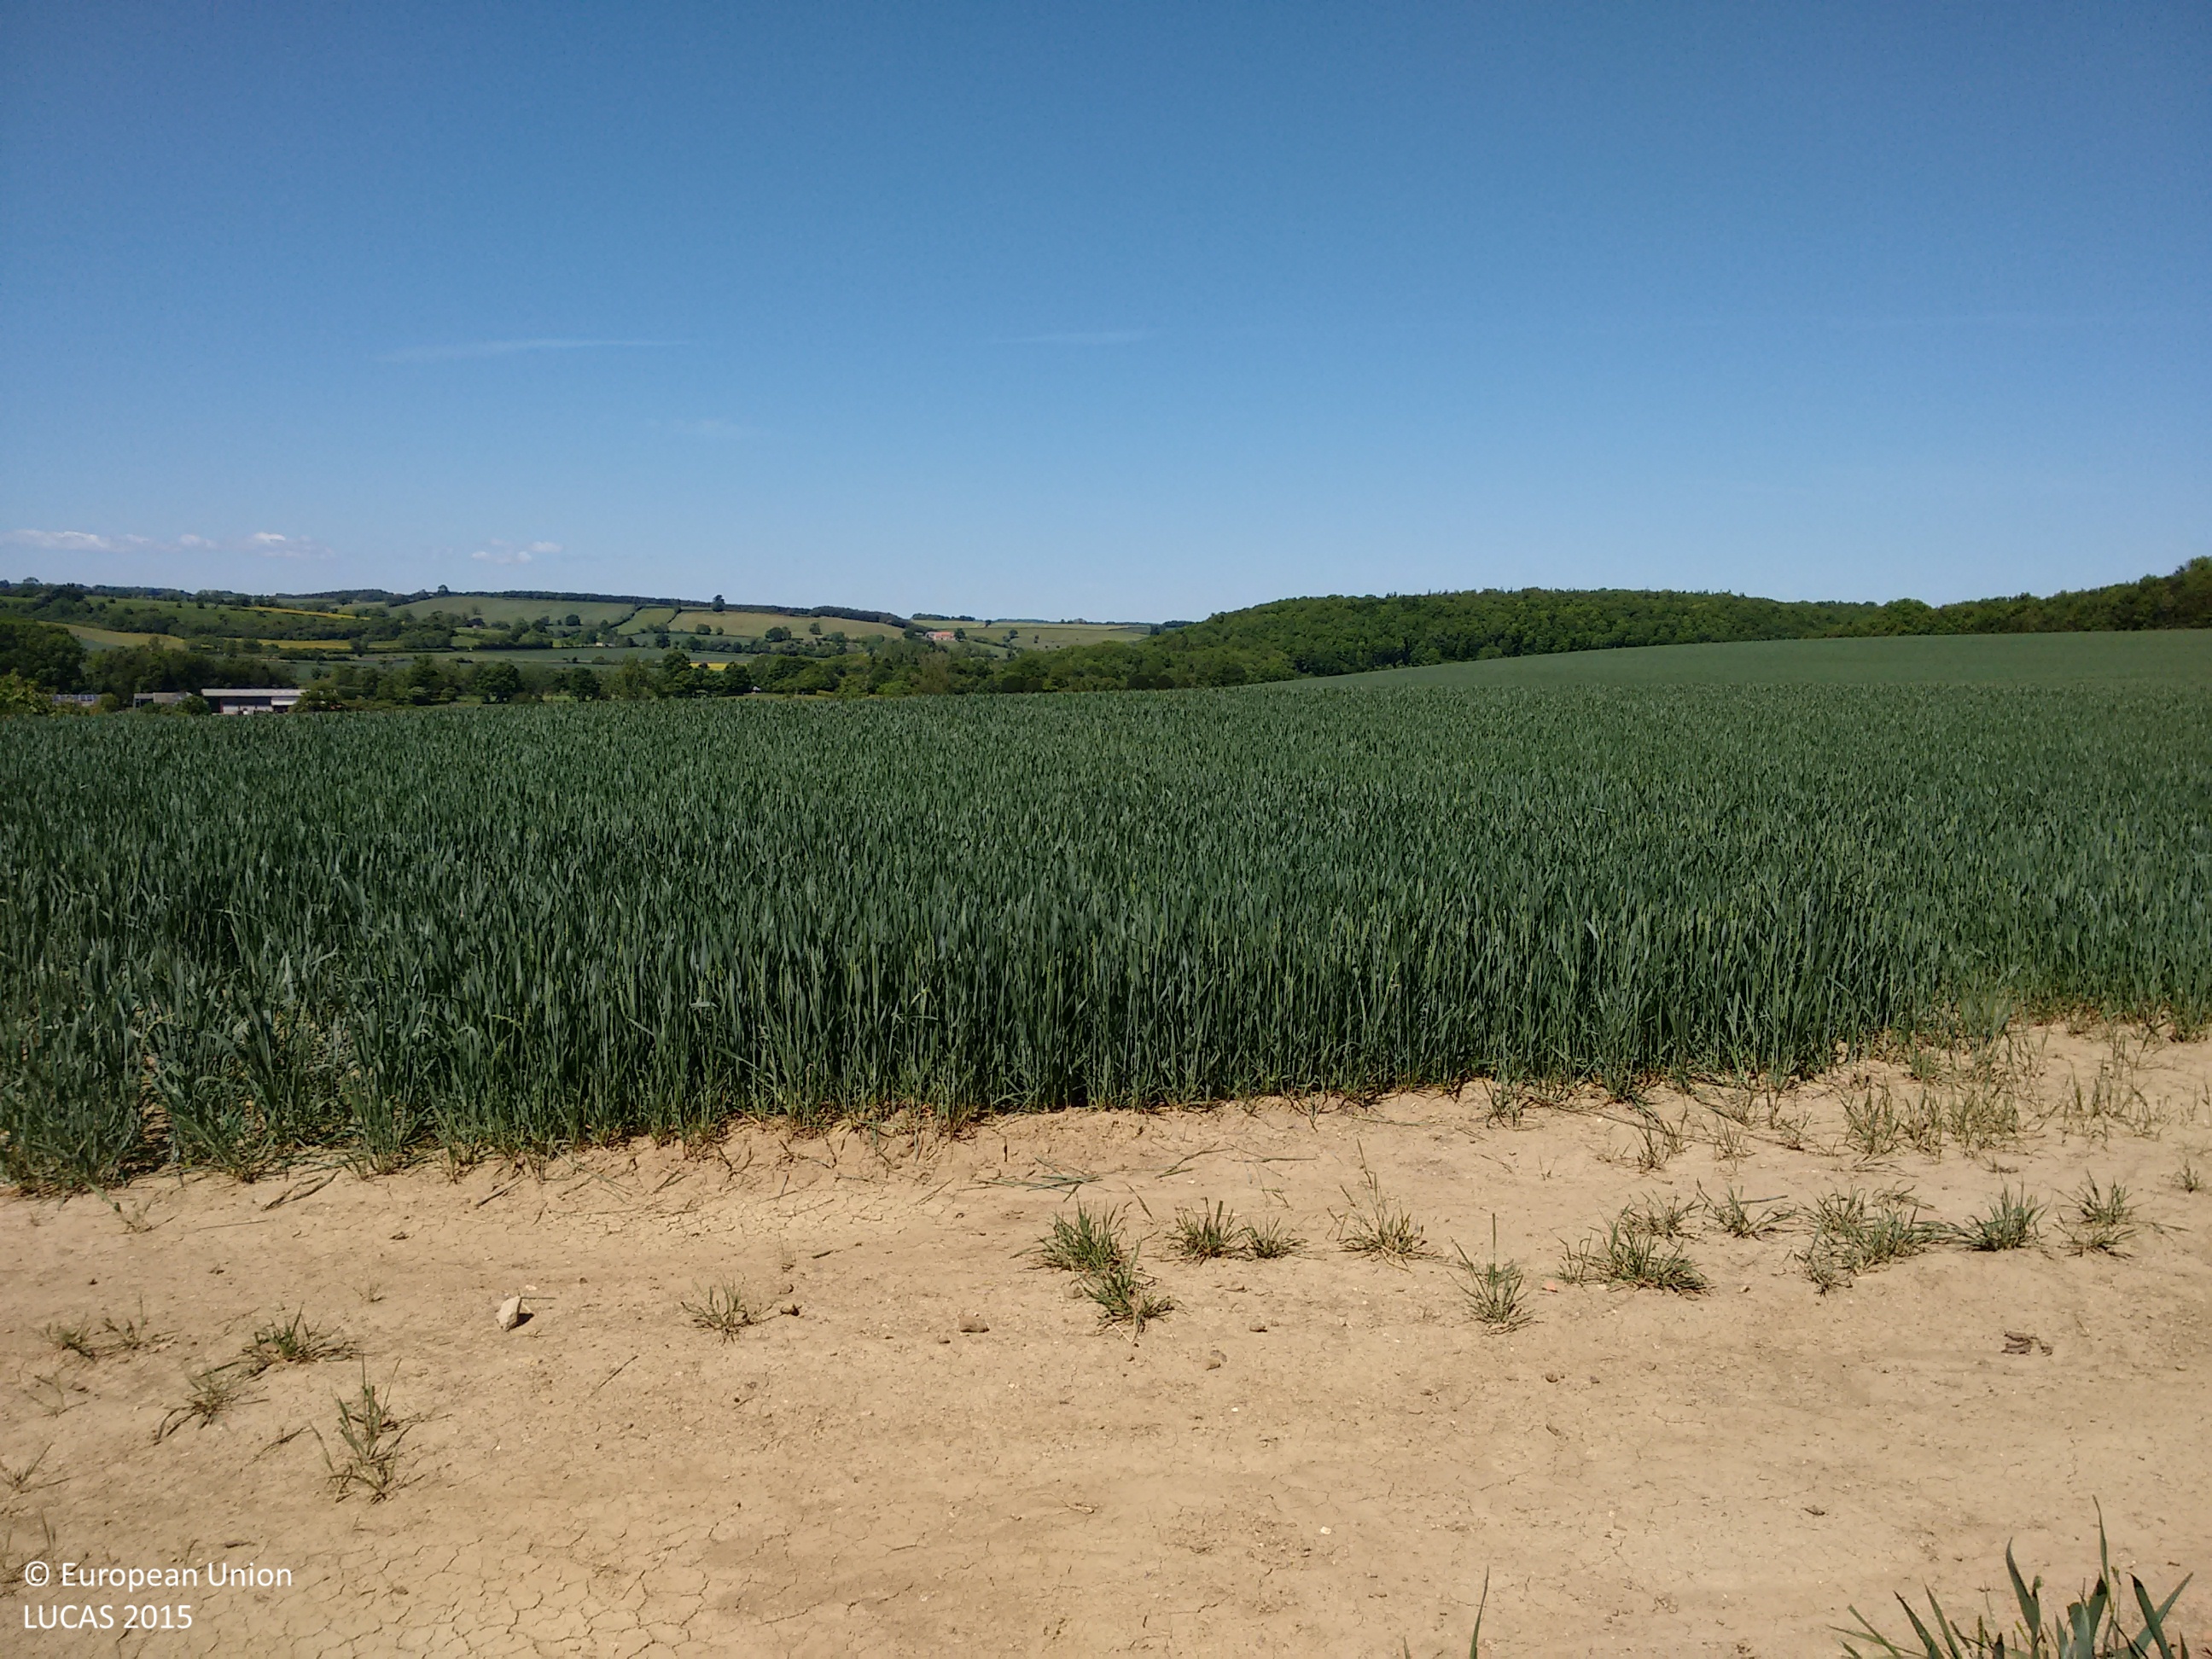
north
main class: Cropland
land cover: Common wheat
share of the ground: > 75 %
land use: Agriculture (excluding fallow land and kitchen gardens)
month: June
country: GB
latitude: 54.0543
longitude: -0.8713
